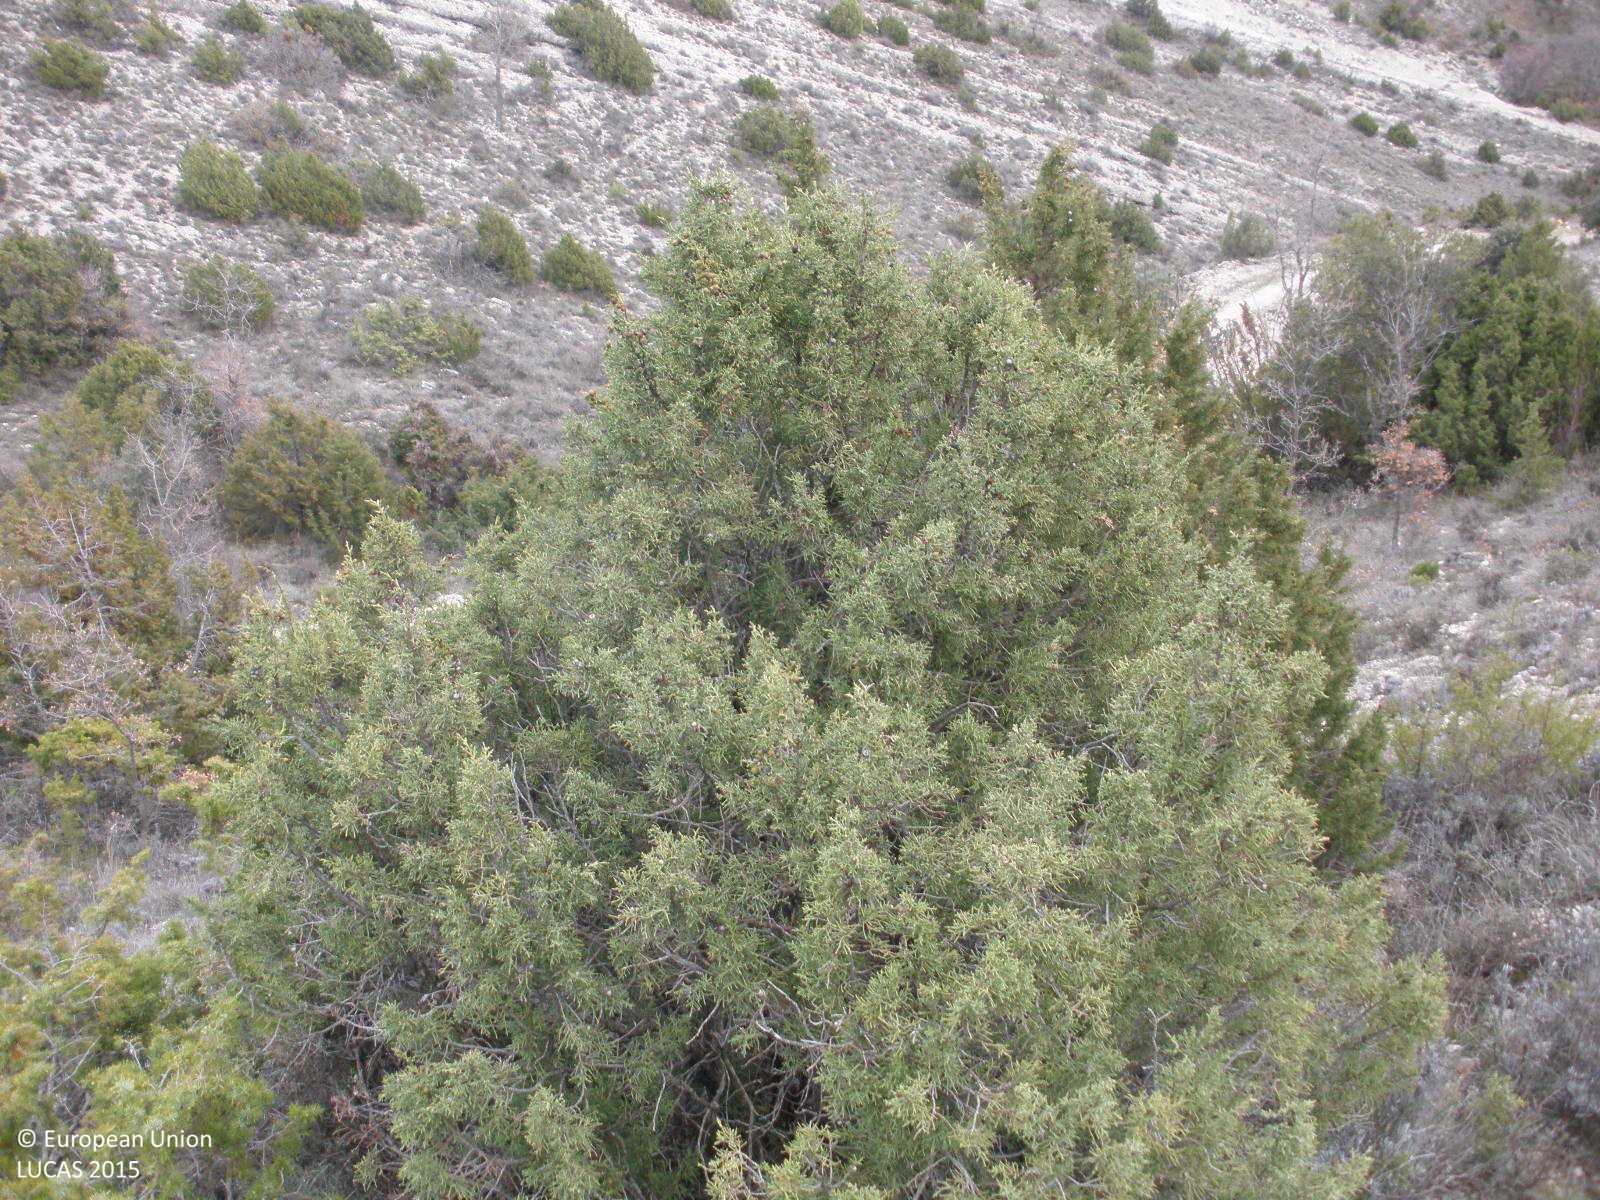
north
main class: Woodland
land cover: Other coniferous woodland
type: coniferous forest of the mediterranean region
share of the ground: > 75 %
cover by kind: shrubs 40 %, coniferous forest trees 30 %, consolidated bare surface 30 %
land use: Semi-natural and natural areas not in use
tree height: < 5 m
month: April
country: ES
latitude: 41.0354
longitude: -1.1396
